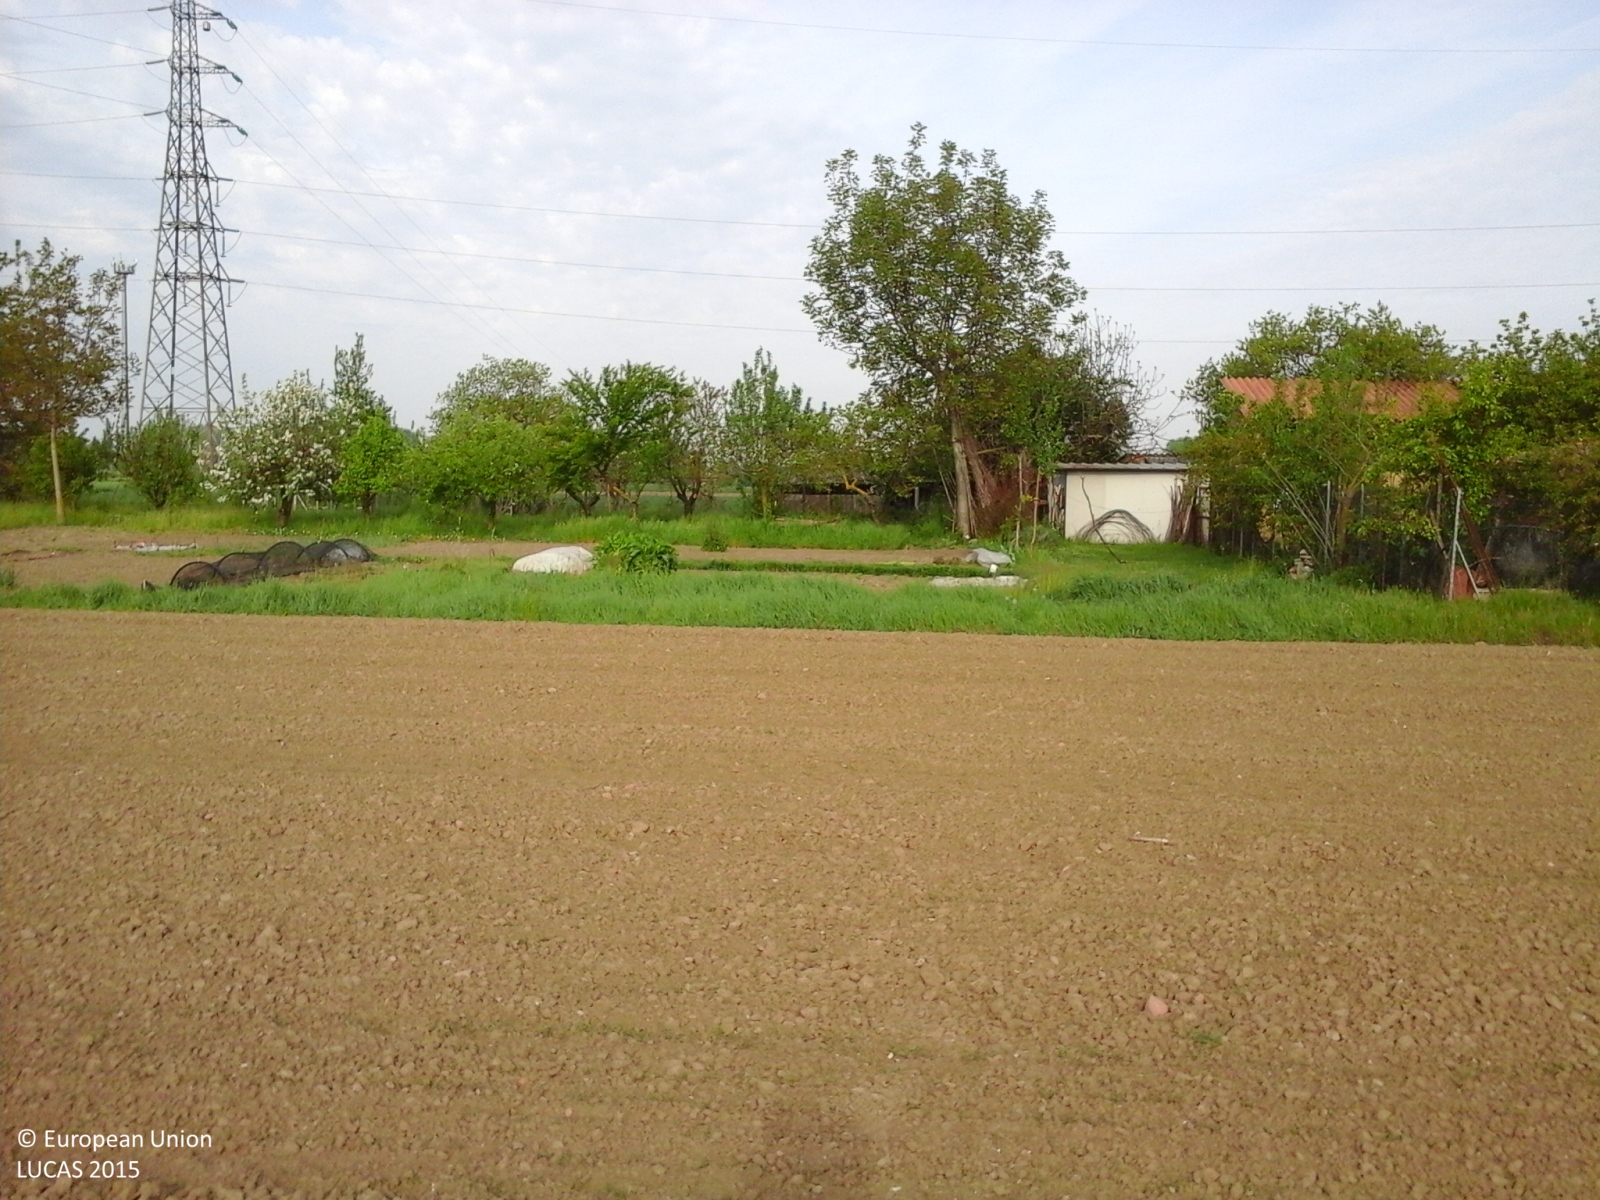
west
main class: Cropland
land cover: Lucerne
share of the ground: < 10 %
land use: Agriculture (excluding fallow land and kitchen gardens)
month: April
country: IT
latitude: 45.0880
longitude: 9.3786
